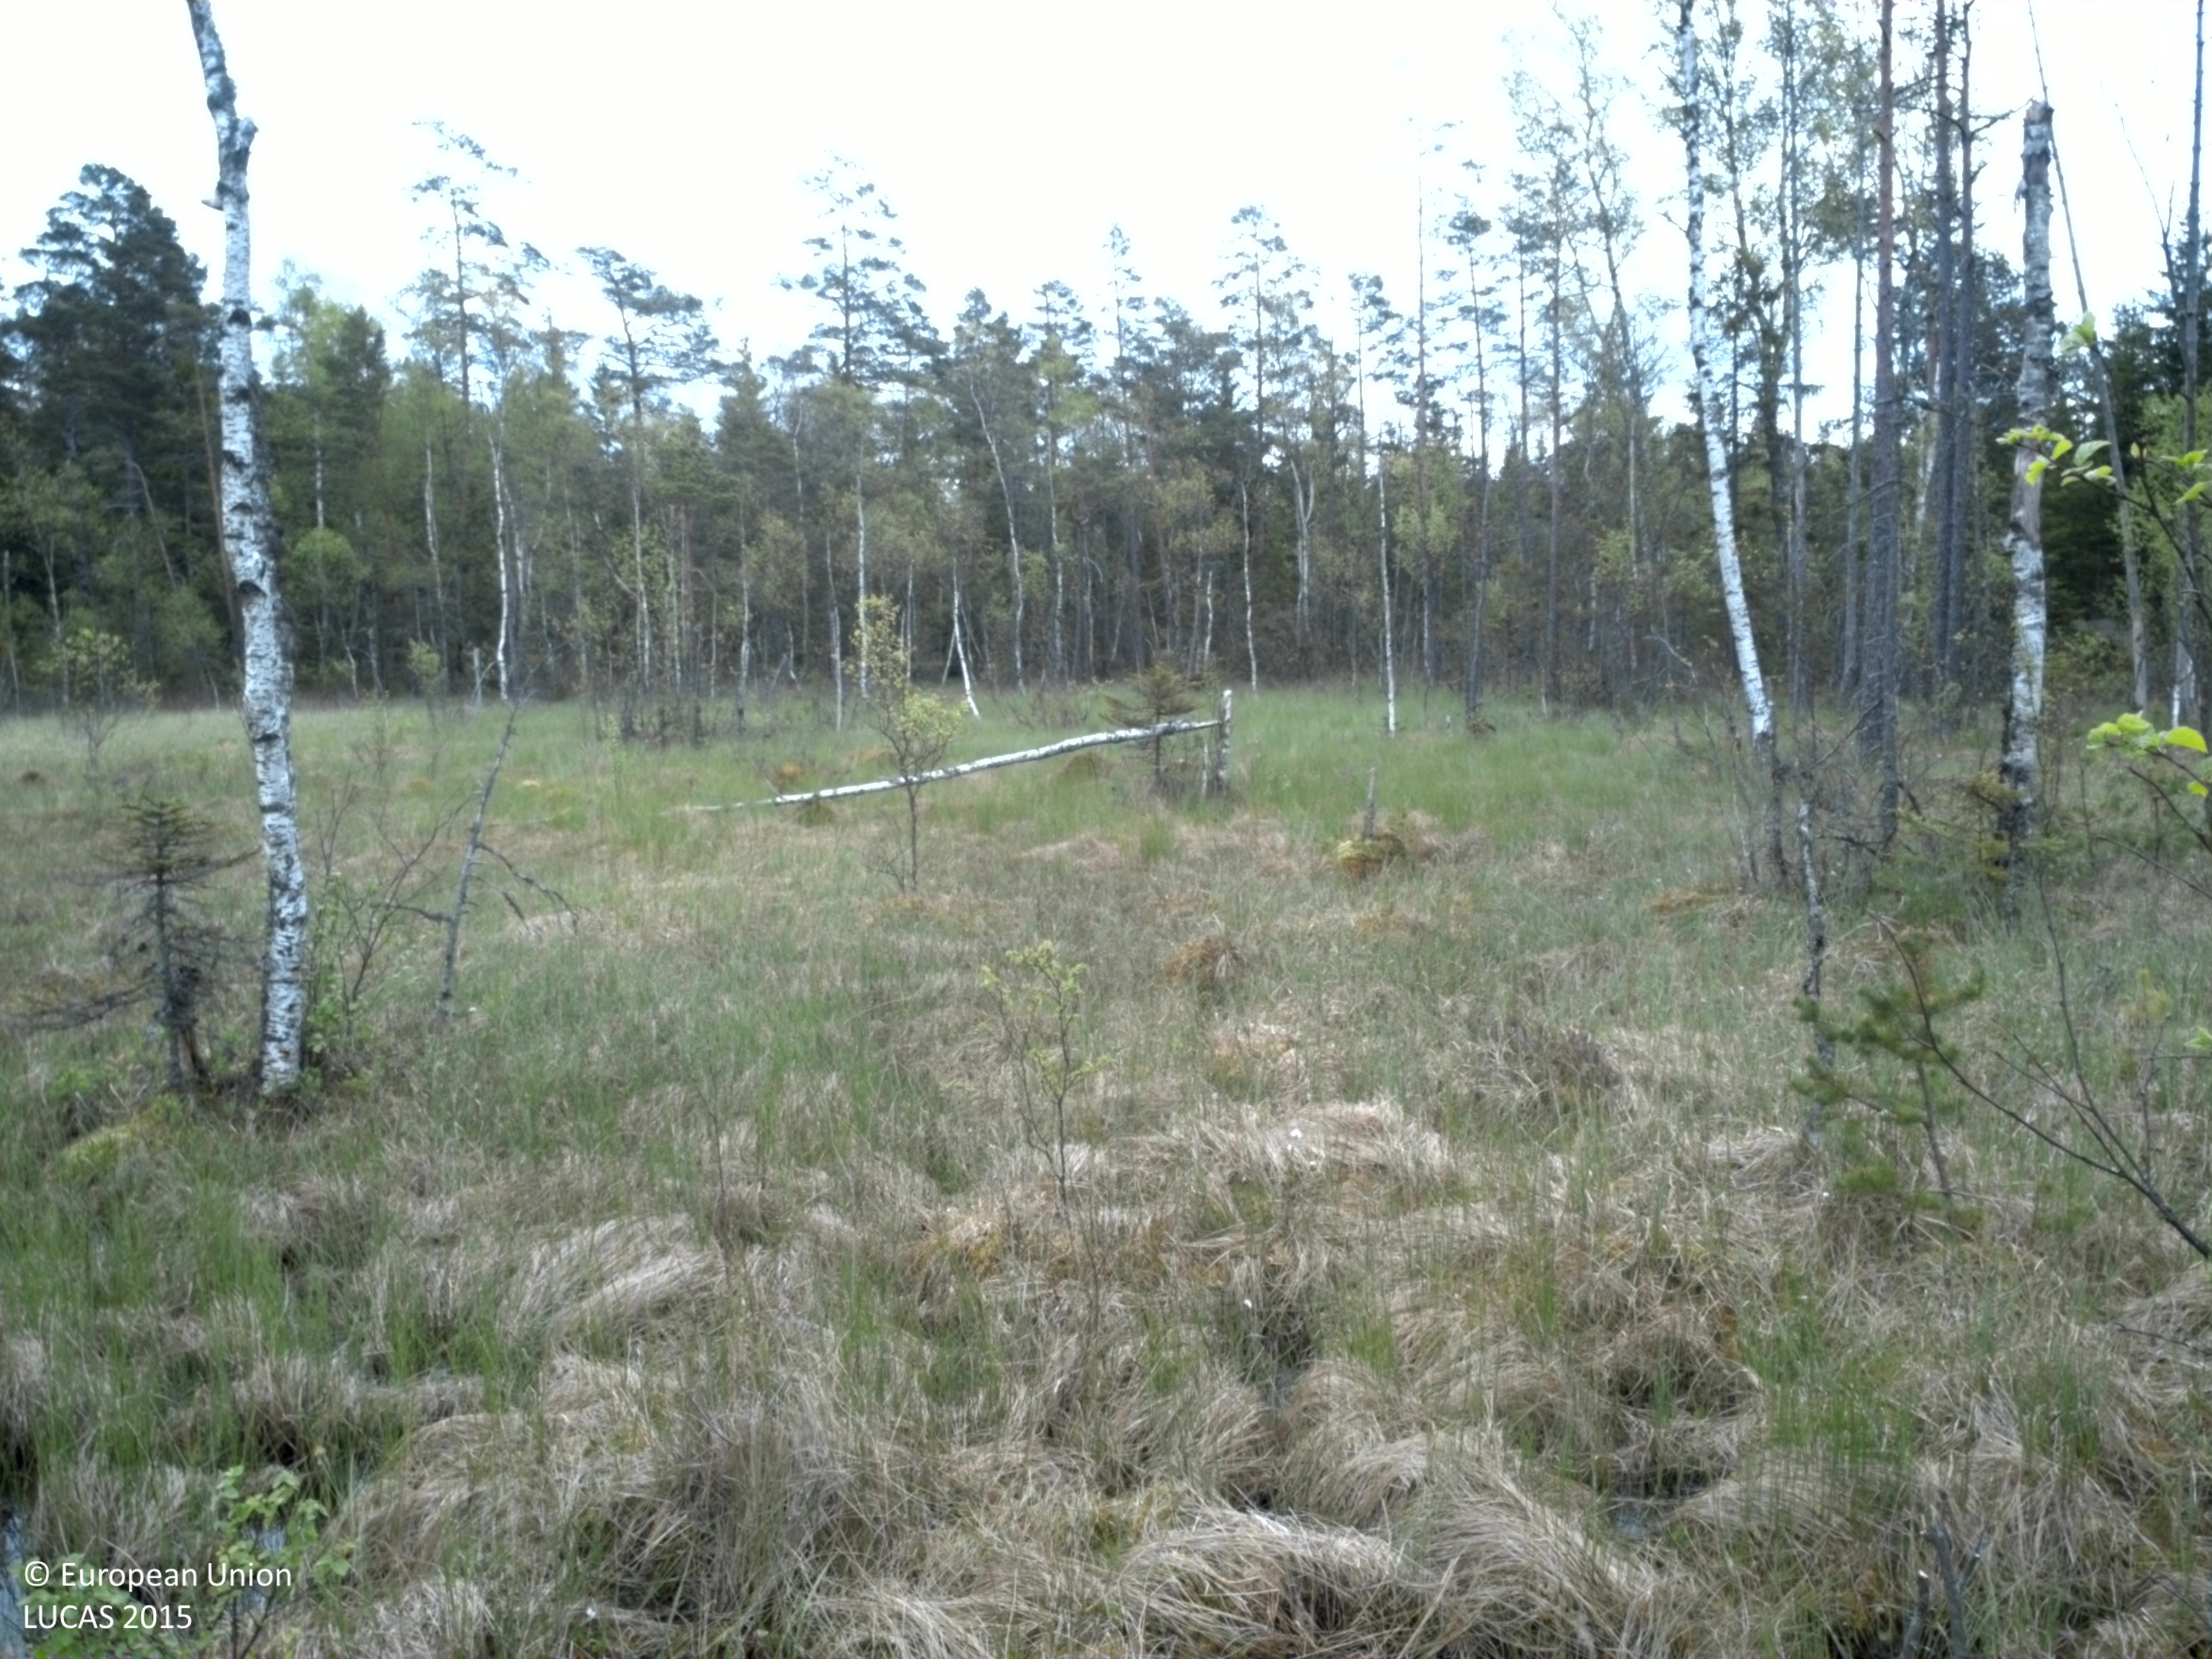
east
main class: Woodland
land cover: Broadleaved woodland
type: hemiboreal forest and nemoral coniferous forest and mixed broadleaved-coniferous forest
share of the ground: 25 - 50 %
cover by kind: broadleaved forest trees 40 %, herbaceous plants 30 %, lichens and mosses 30 %
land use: Forestry
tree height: > 5 m
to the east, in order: Broadleaved woodland; Spruce dominated mixed woodland; Spruce dominated coniferous woodland; Spruce dominated mixed woodland; Tracks; Spruce dominated coniferous woodland; Spruce dominated mixed woodland; Rivers and streams; Spruce dominated coniferous woodland
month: May
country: SE
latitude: 56.8109
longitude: 15.4527
